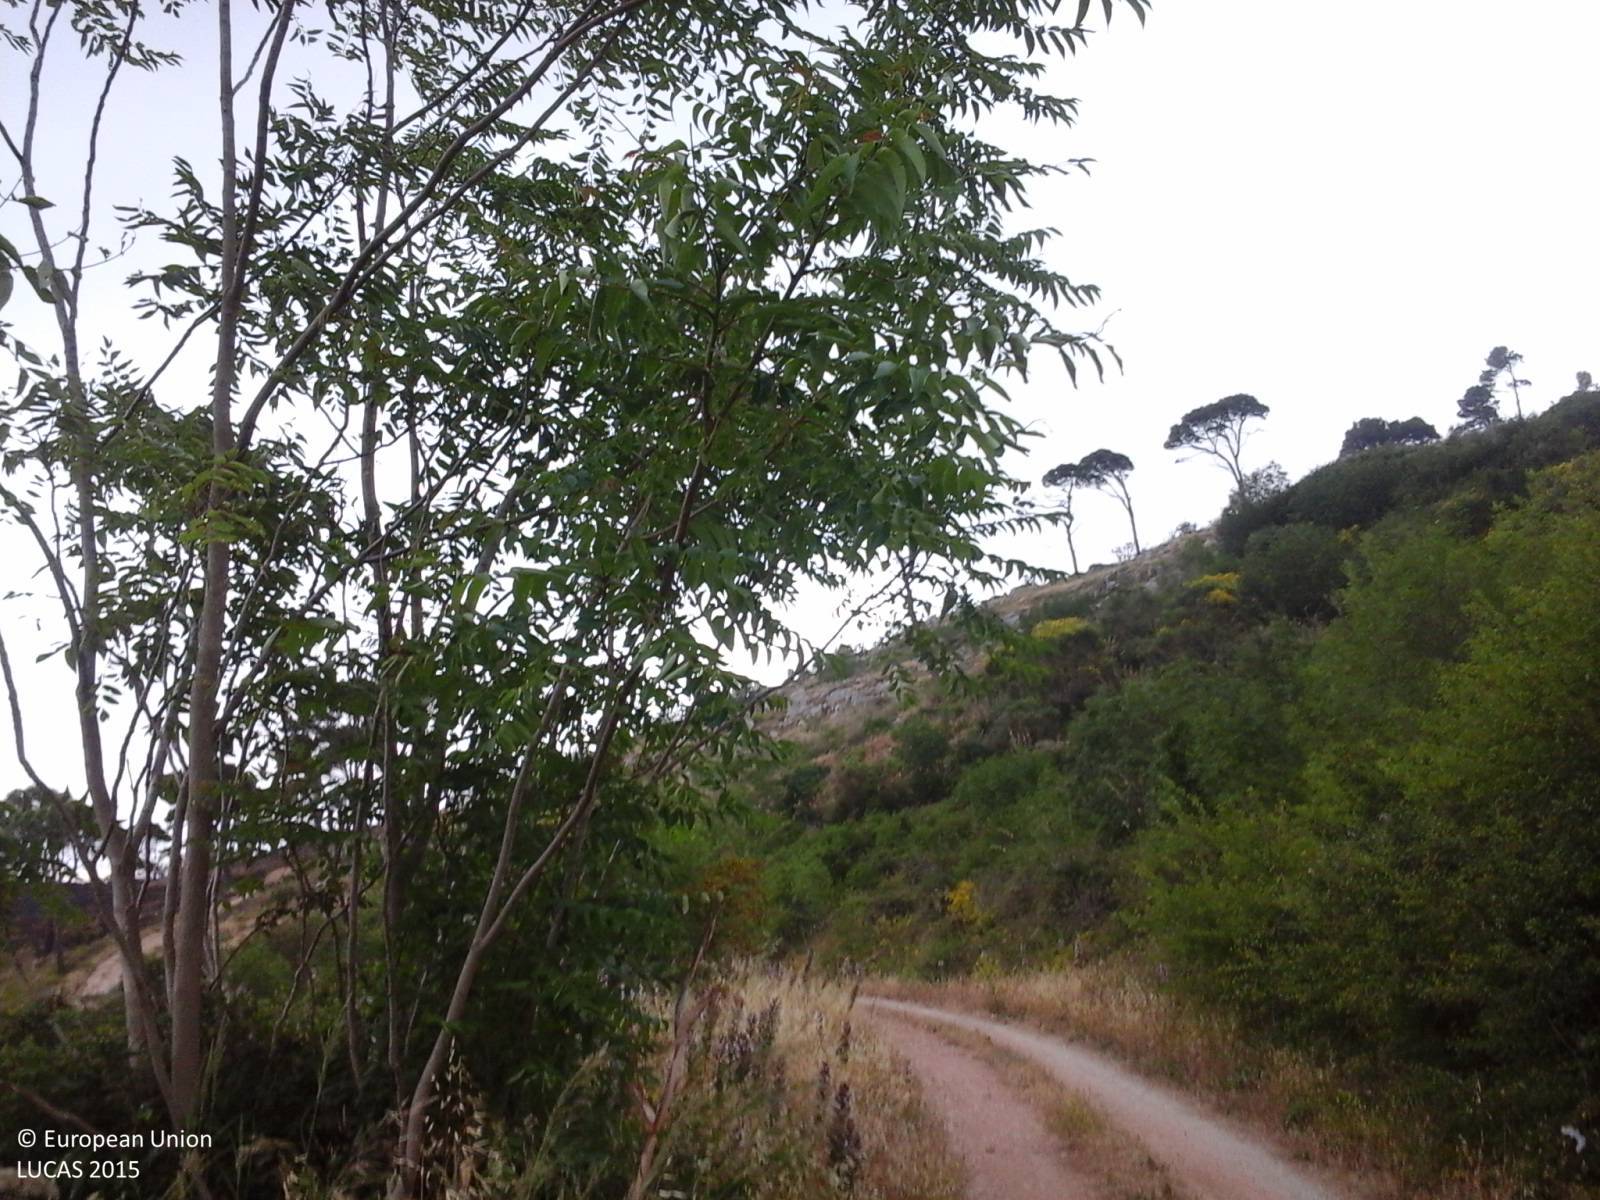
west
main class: Shrubland
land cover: Shrubland with sparse tree cover
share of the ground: > 75 %
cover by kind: herbaceous plants 85 %, shrubs 10 %, broadleaved forest trees 5 %
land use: Semi-natural and natural areas not in use
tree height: < 5 m
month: June
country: IT
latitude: 38.0391
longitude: 12.5905
